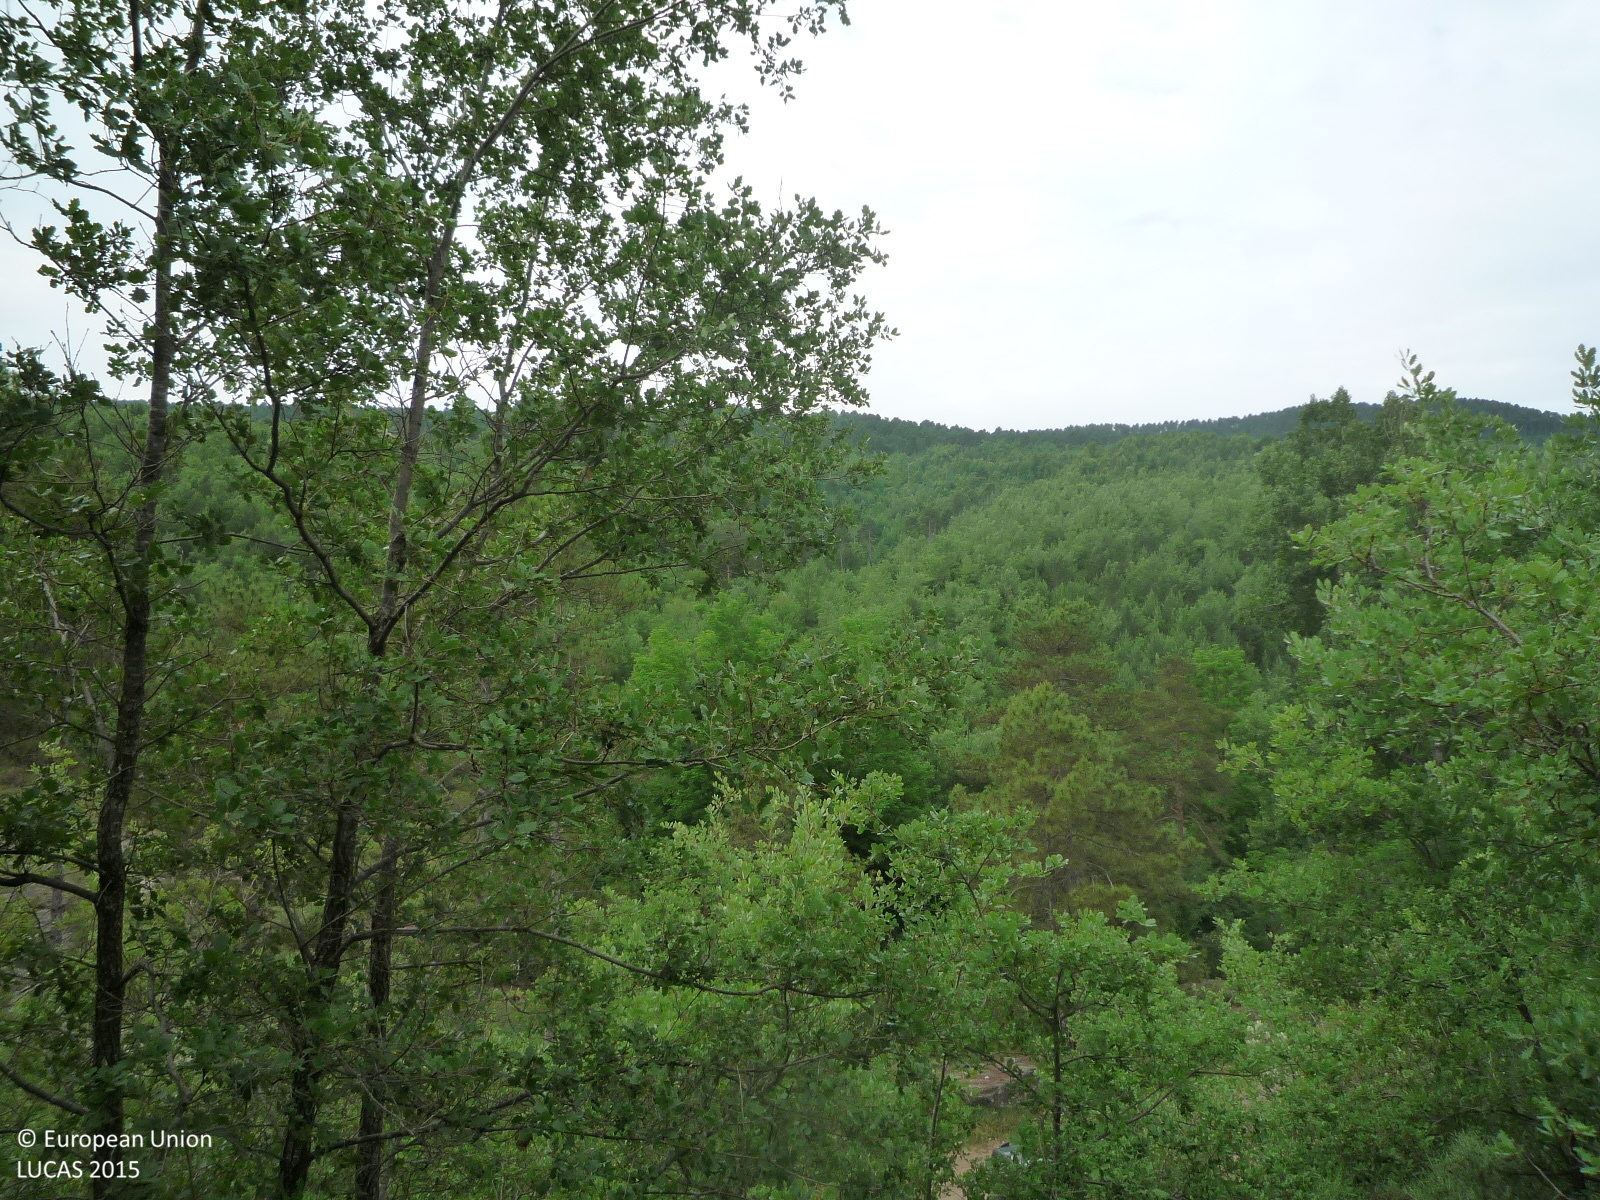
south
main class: Woodland
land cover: Broadleaved woodland
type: broadleaved evergreen forest
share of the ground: > 75 %
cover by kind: broadleaved forest trees 80 %, shrubs 15 %, herbaceous plants 5 %
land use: Semi-natural and natural areas not in use
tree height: < 5 m
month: June
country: ES
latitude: 41.9895
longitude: 1.9627
